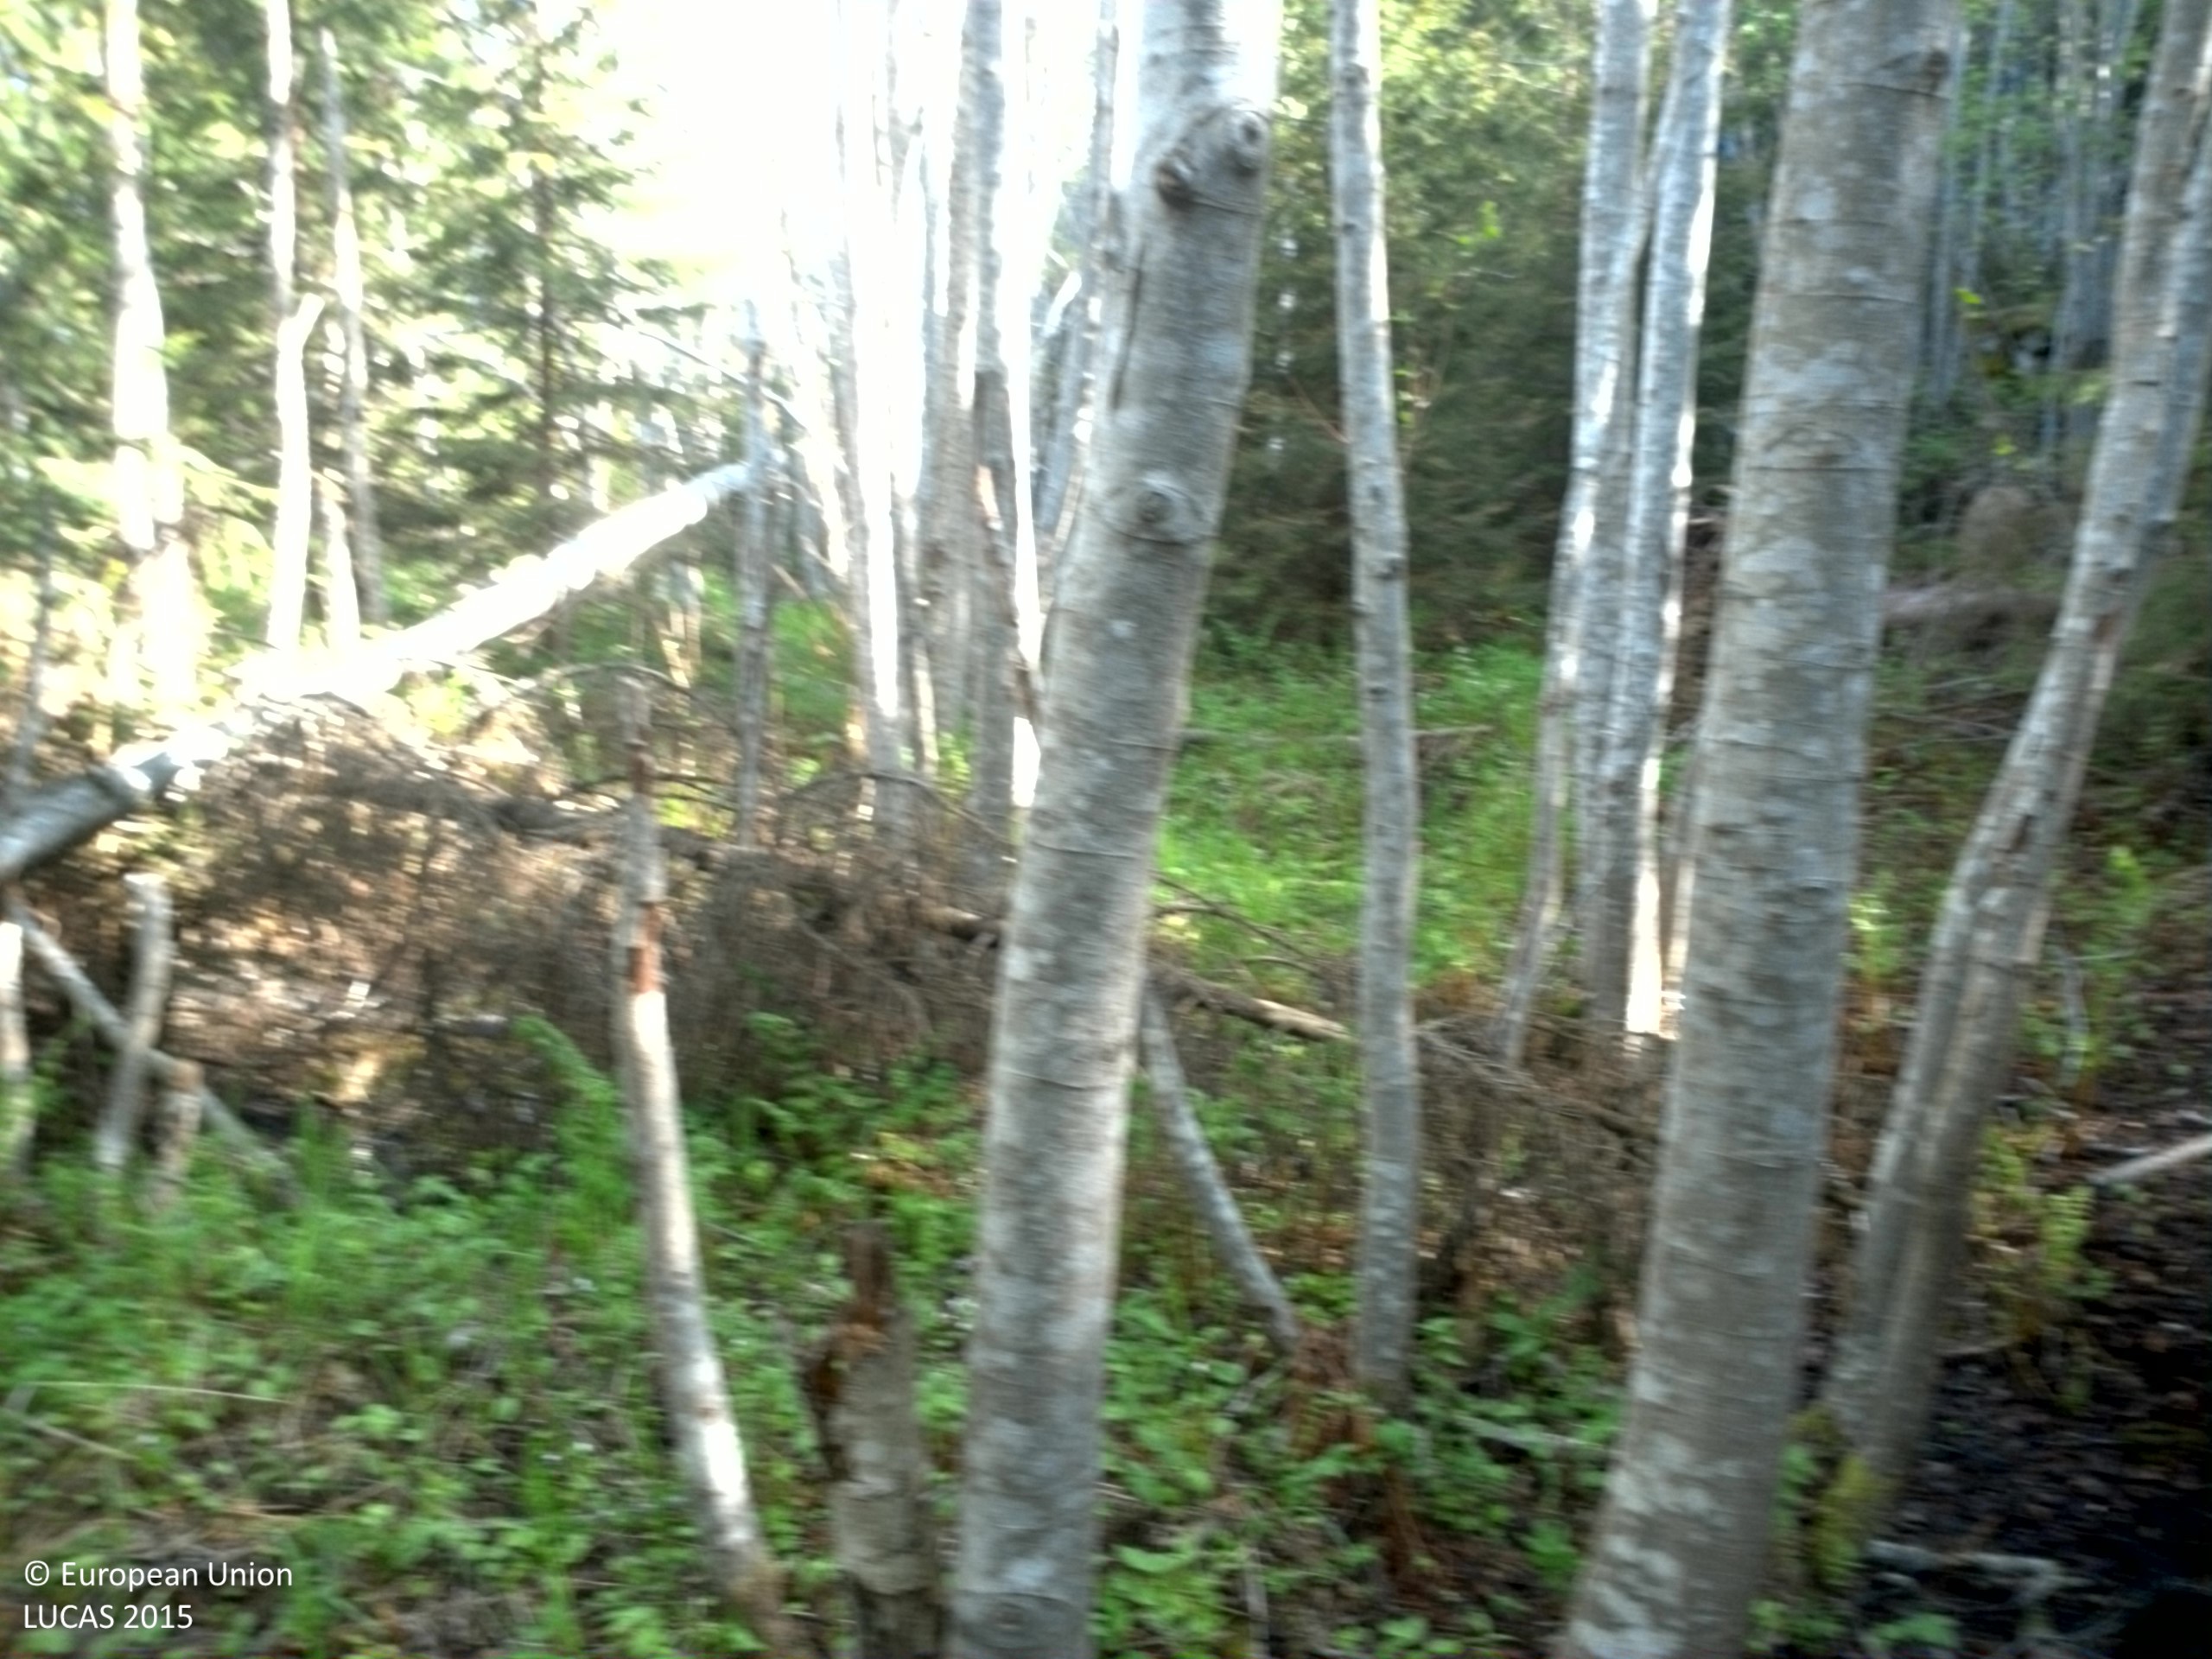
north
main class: Woodland
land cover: Other mixed woodland
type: boreal forest
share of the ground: > 75 %
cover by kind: broadleaved forest trees 60 %, coniferous forest trees 20 %, consolidated bare surface 20 %
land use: Forestry
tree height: > 5 m
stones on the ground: 25 - 50 %
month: May
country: SE
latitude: 62.8061
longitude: 18.1981
